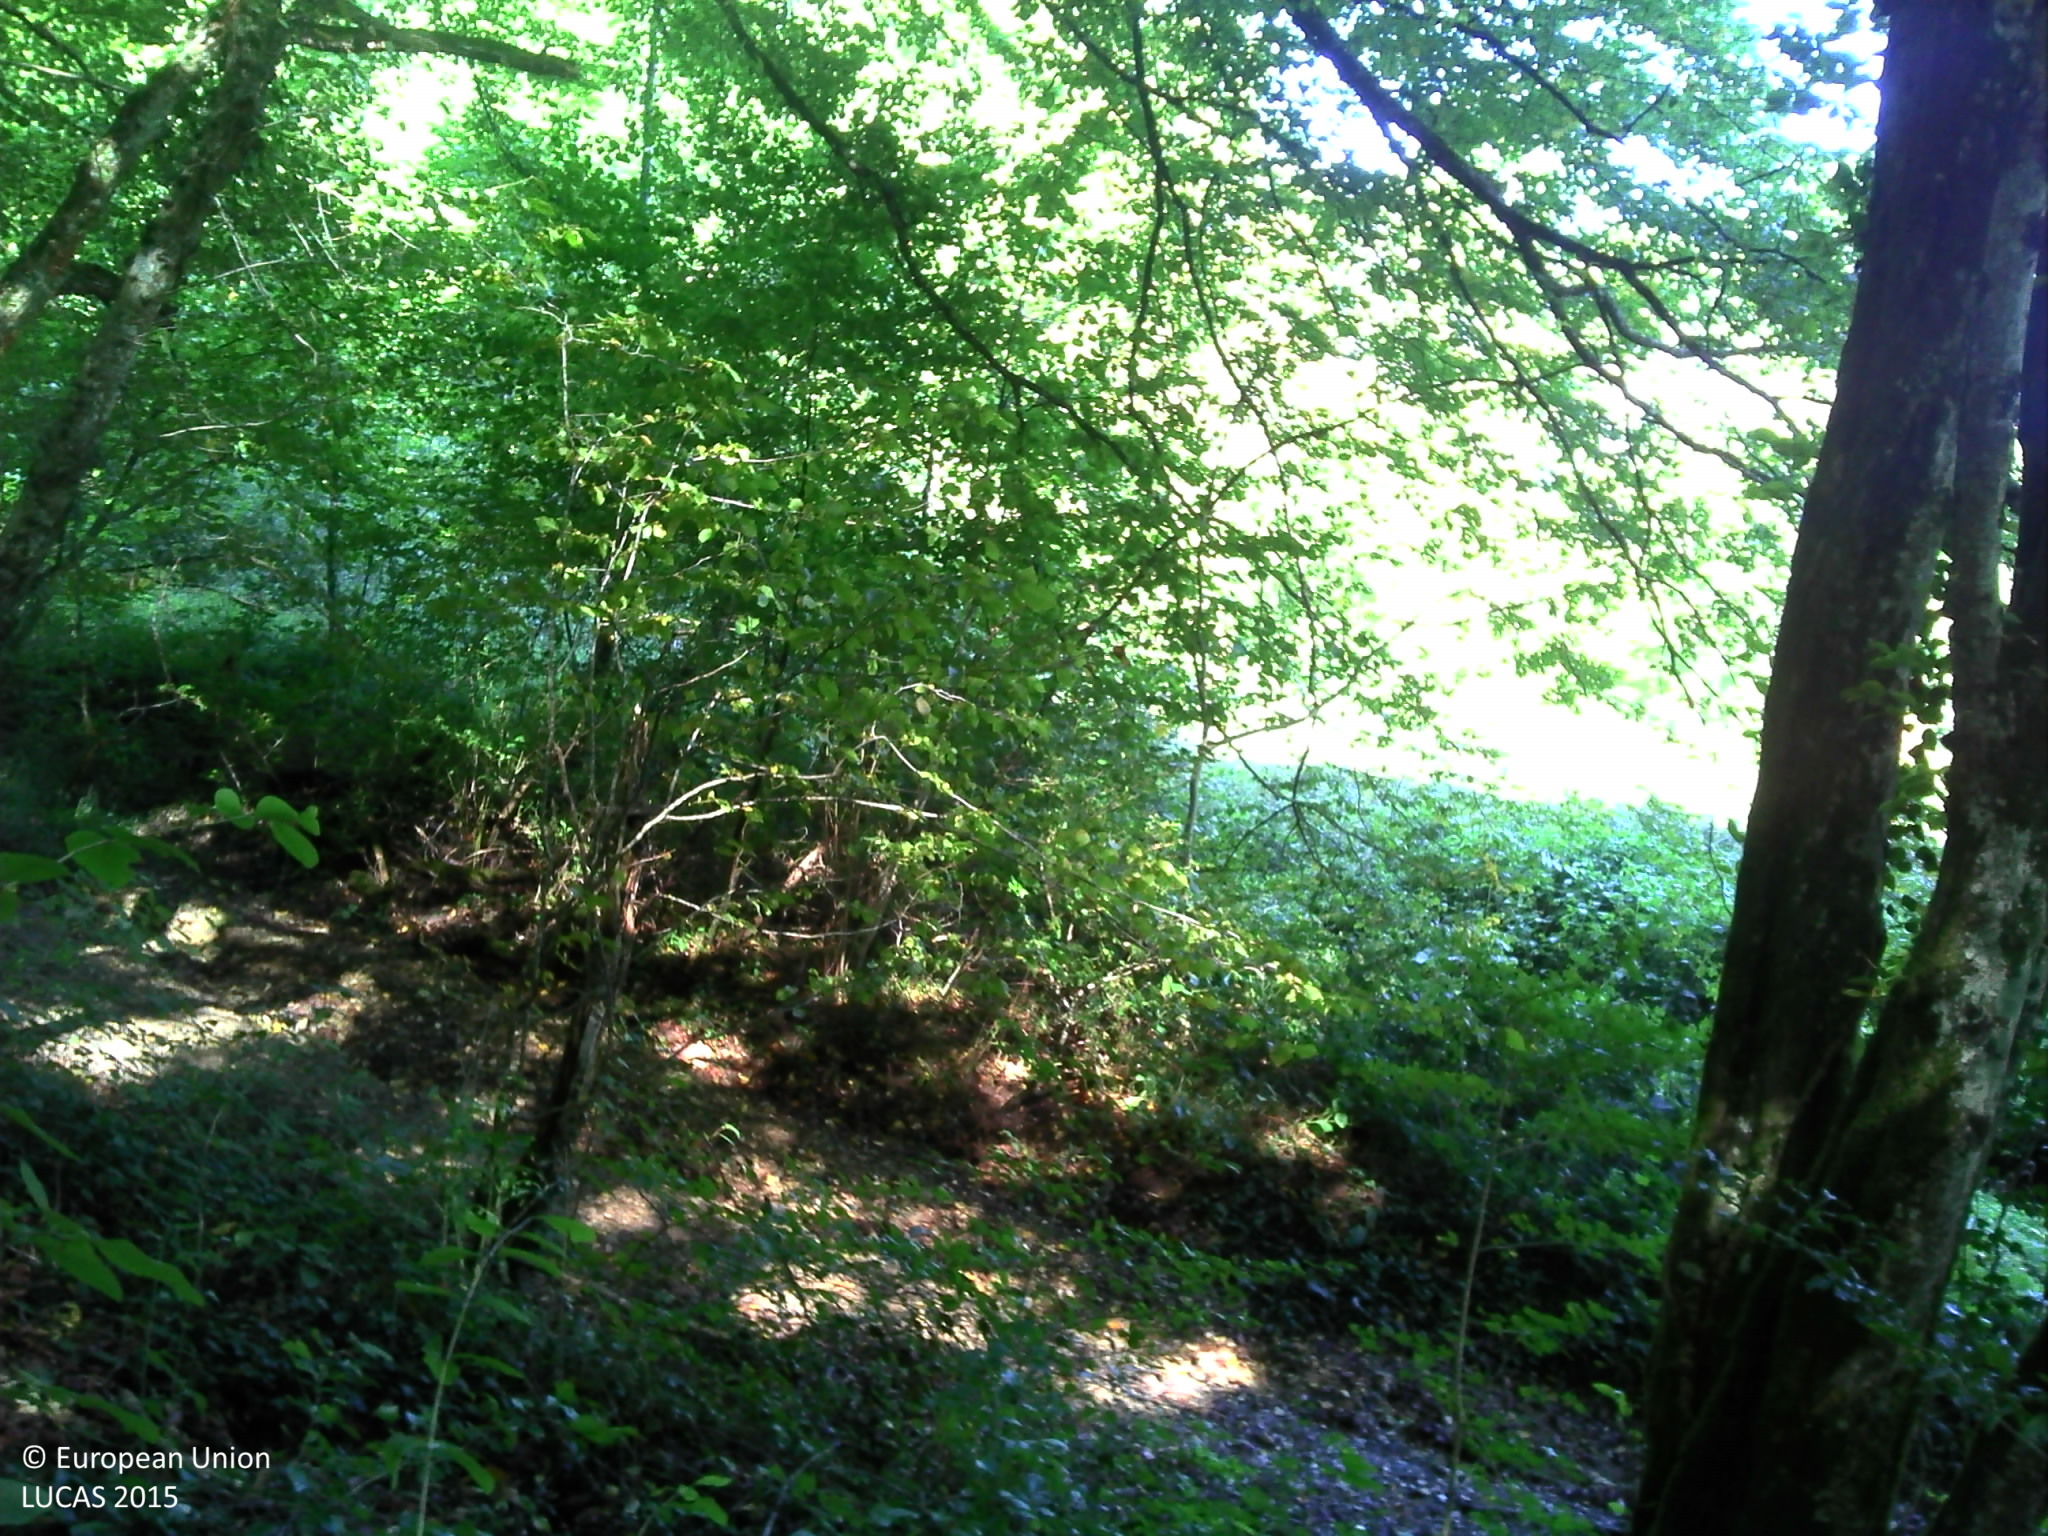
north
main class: Woodland
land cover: Broadleaved woodland
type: mesophytic deciduous forest
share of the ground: > 75 %
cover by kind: broadleaved forest trees 90 %, shrubs 5 %, herbaceous plants 5 %
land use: Forestry
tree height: > 5 m
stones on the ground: < 10 %
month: September
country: FR
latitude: 47.4052
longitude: 6.8877
